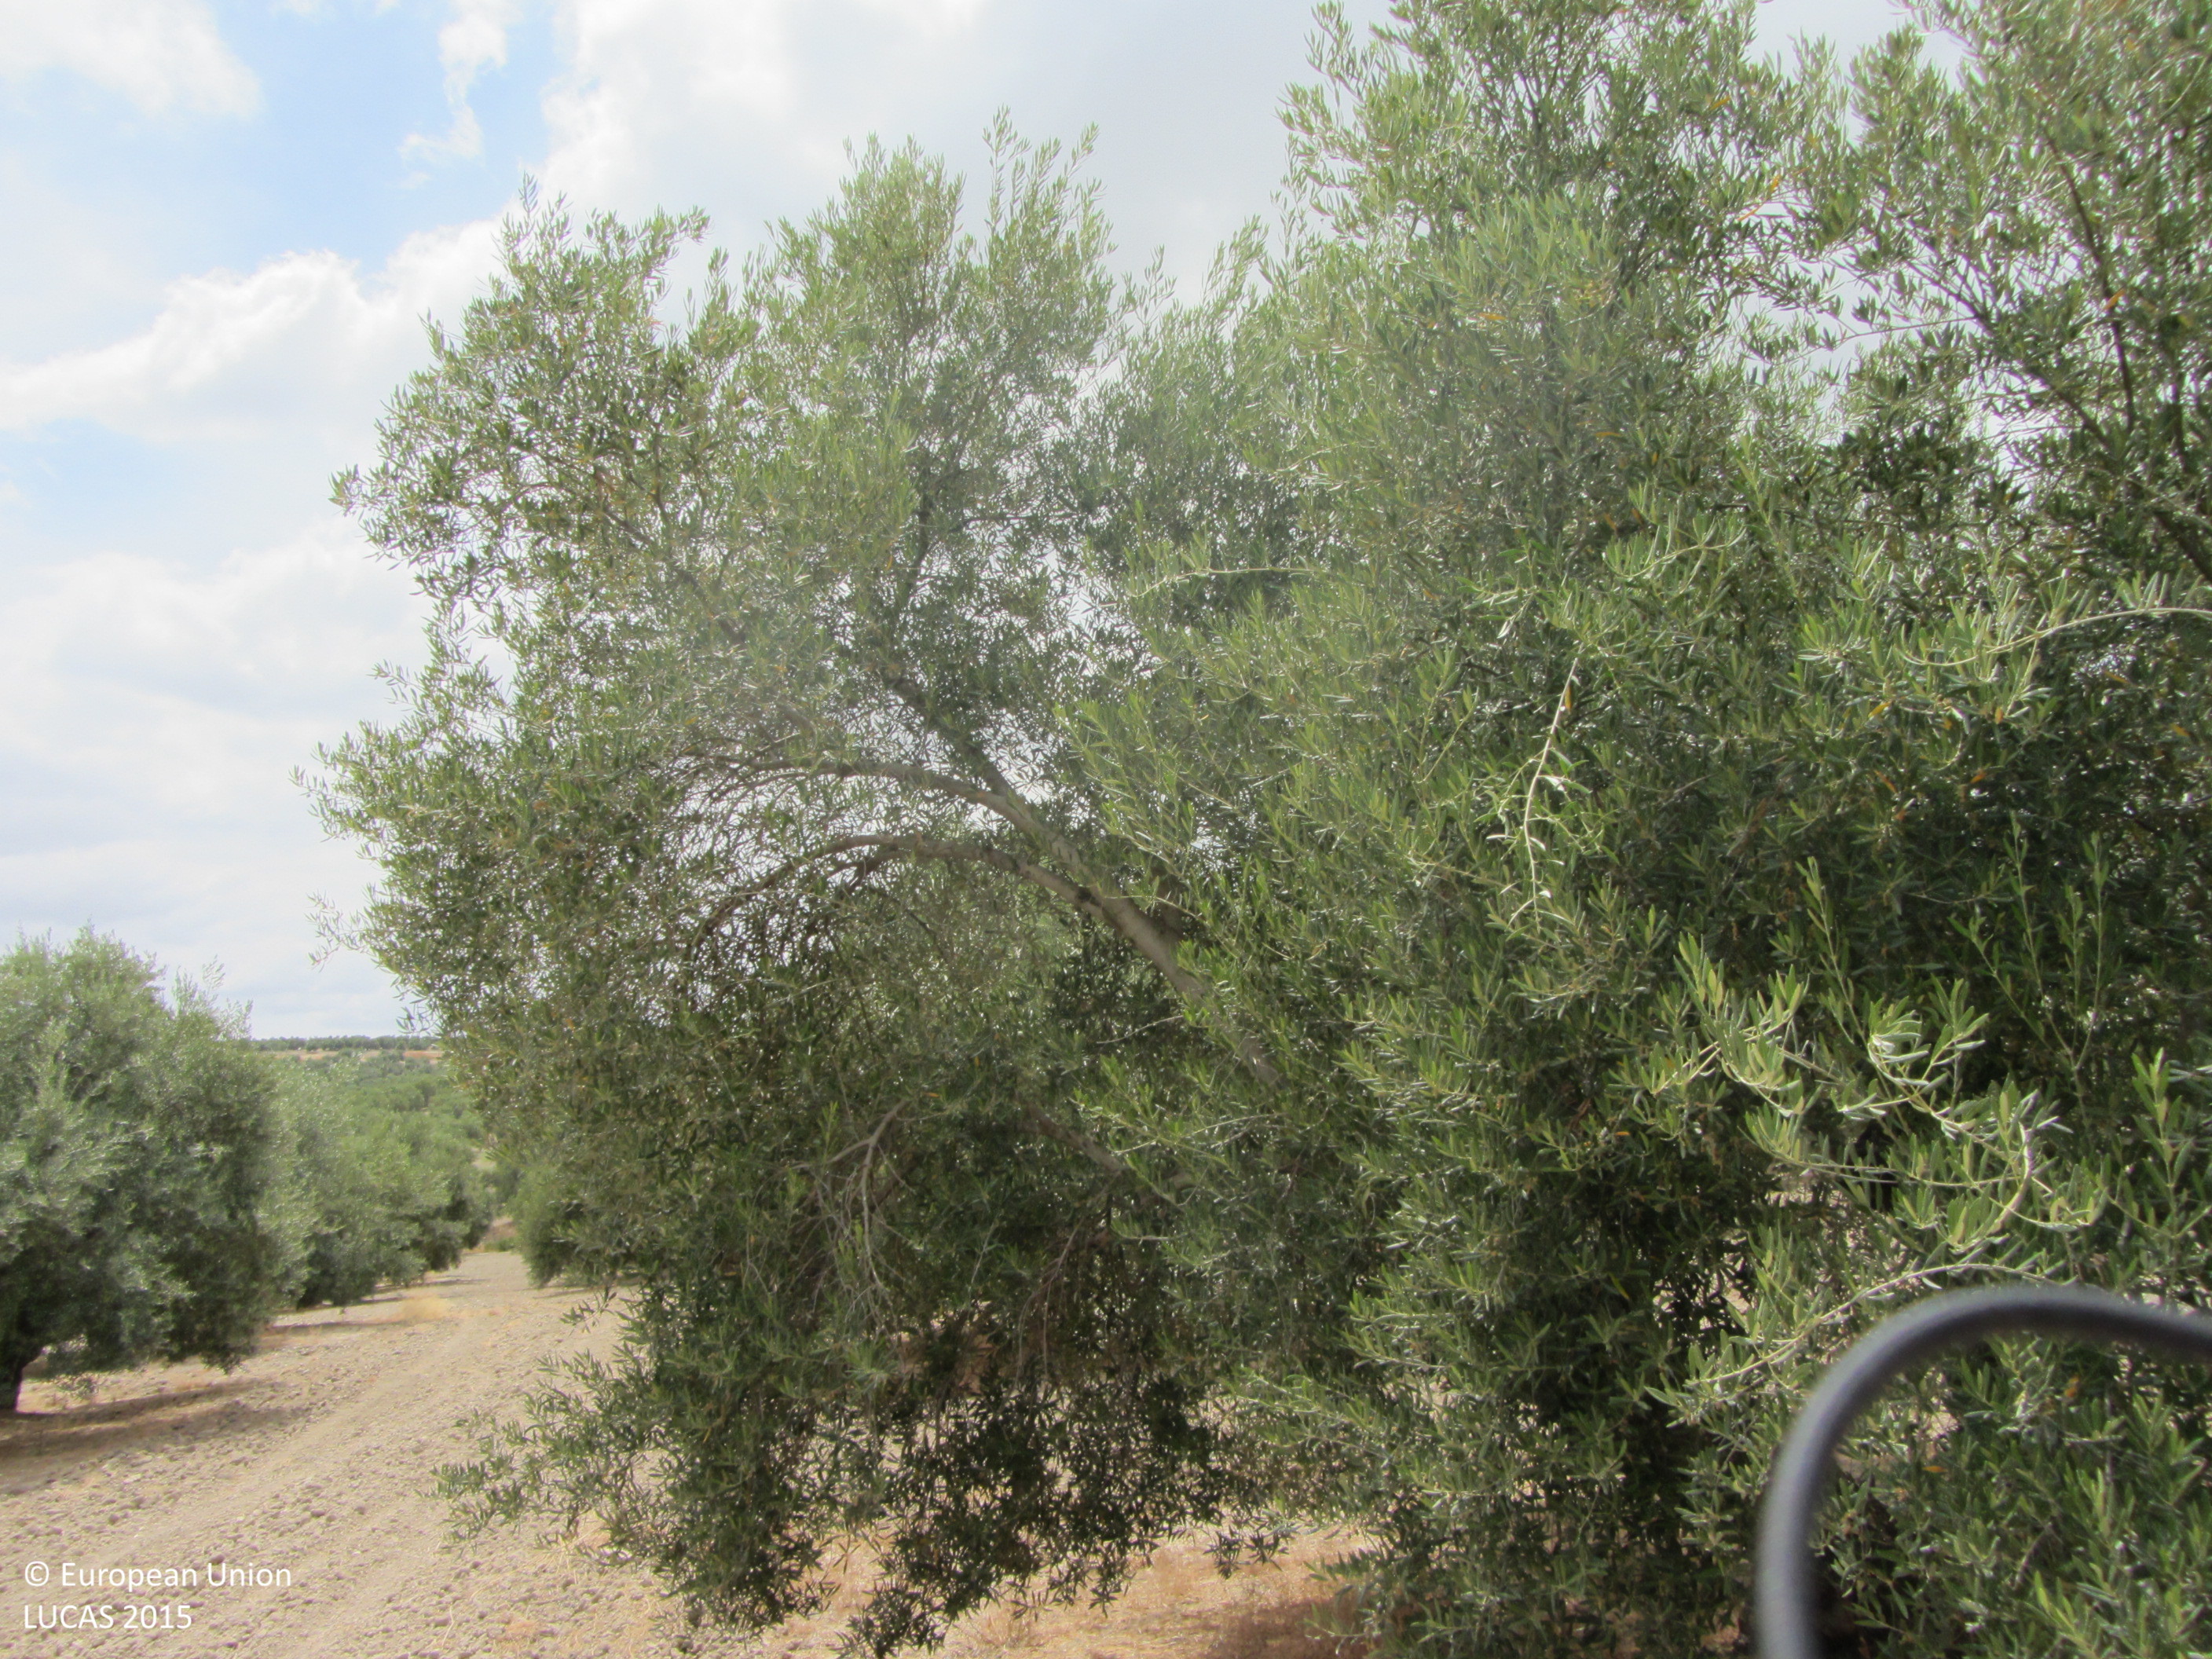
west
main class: Cropland
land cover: Olive groves
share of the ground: 25 - 50 %
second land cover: Other bare soil
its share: > 75 %
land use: Agriculture (excluding fallow land and kitchen gardens)
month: June
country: ES
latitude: 38.0270
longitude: -3.2481
